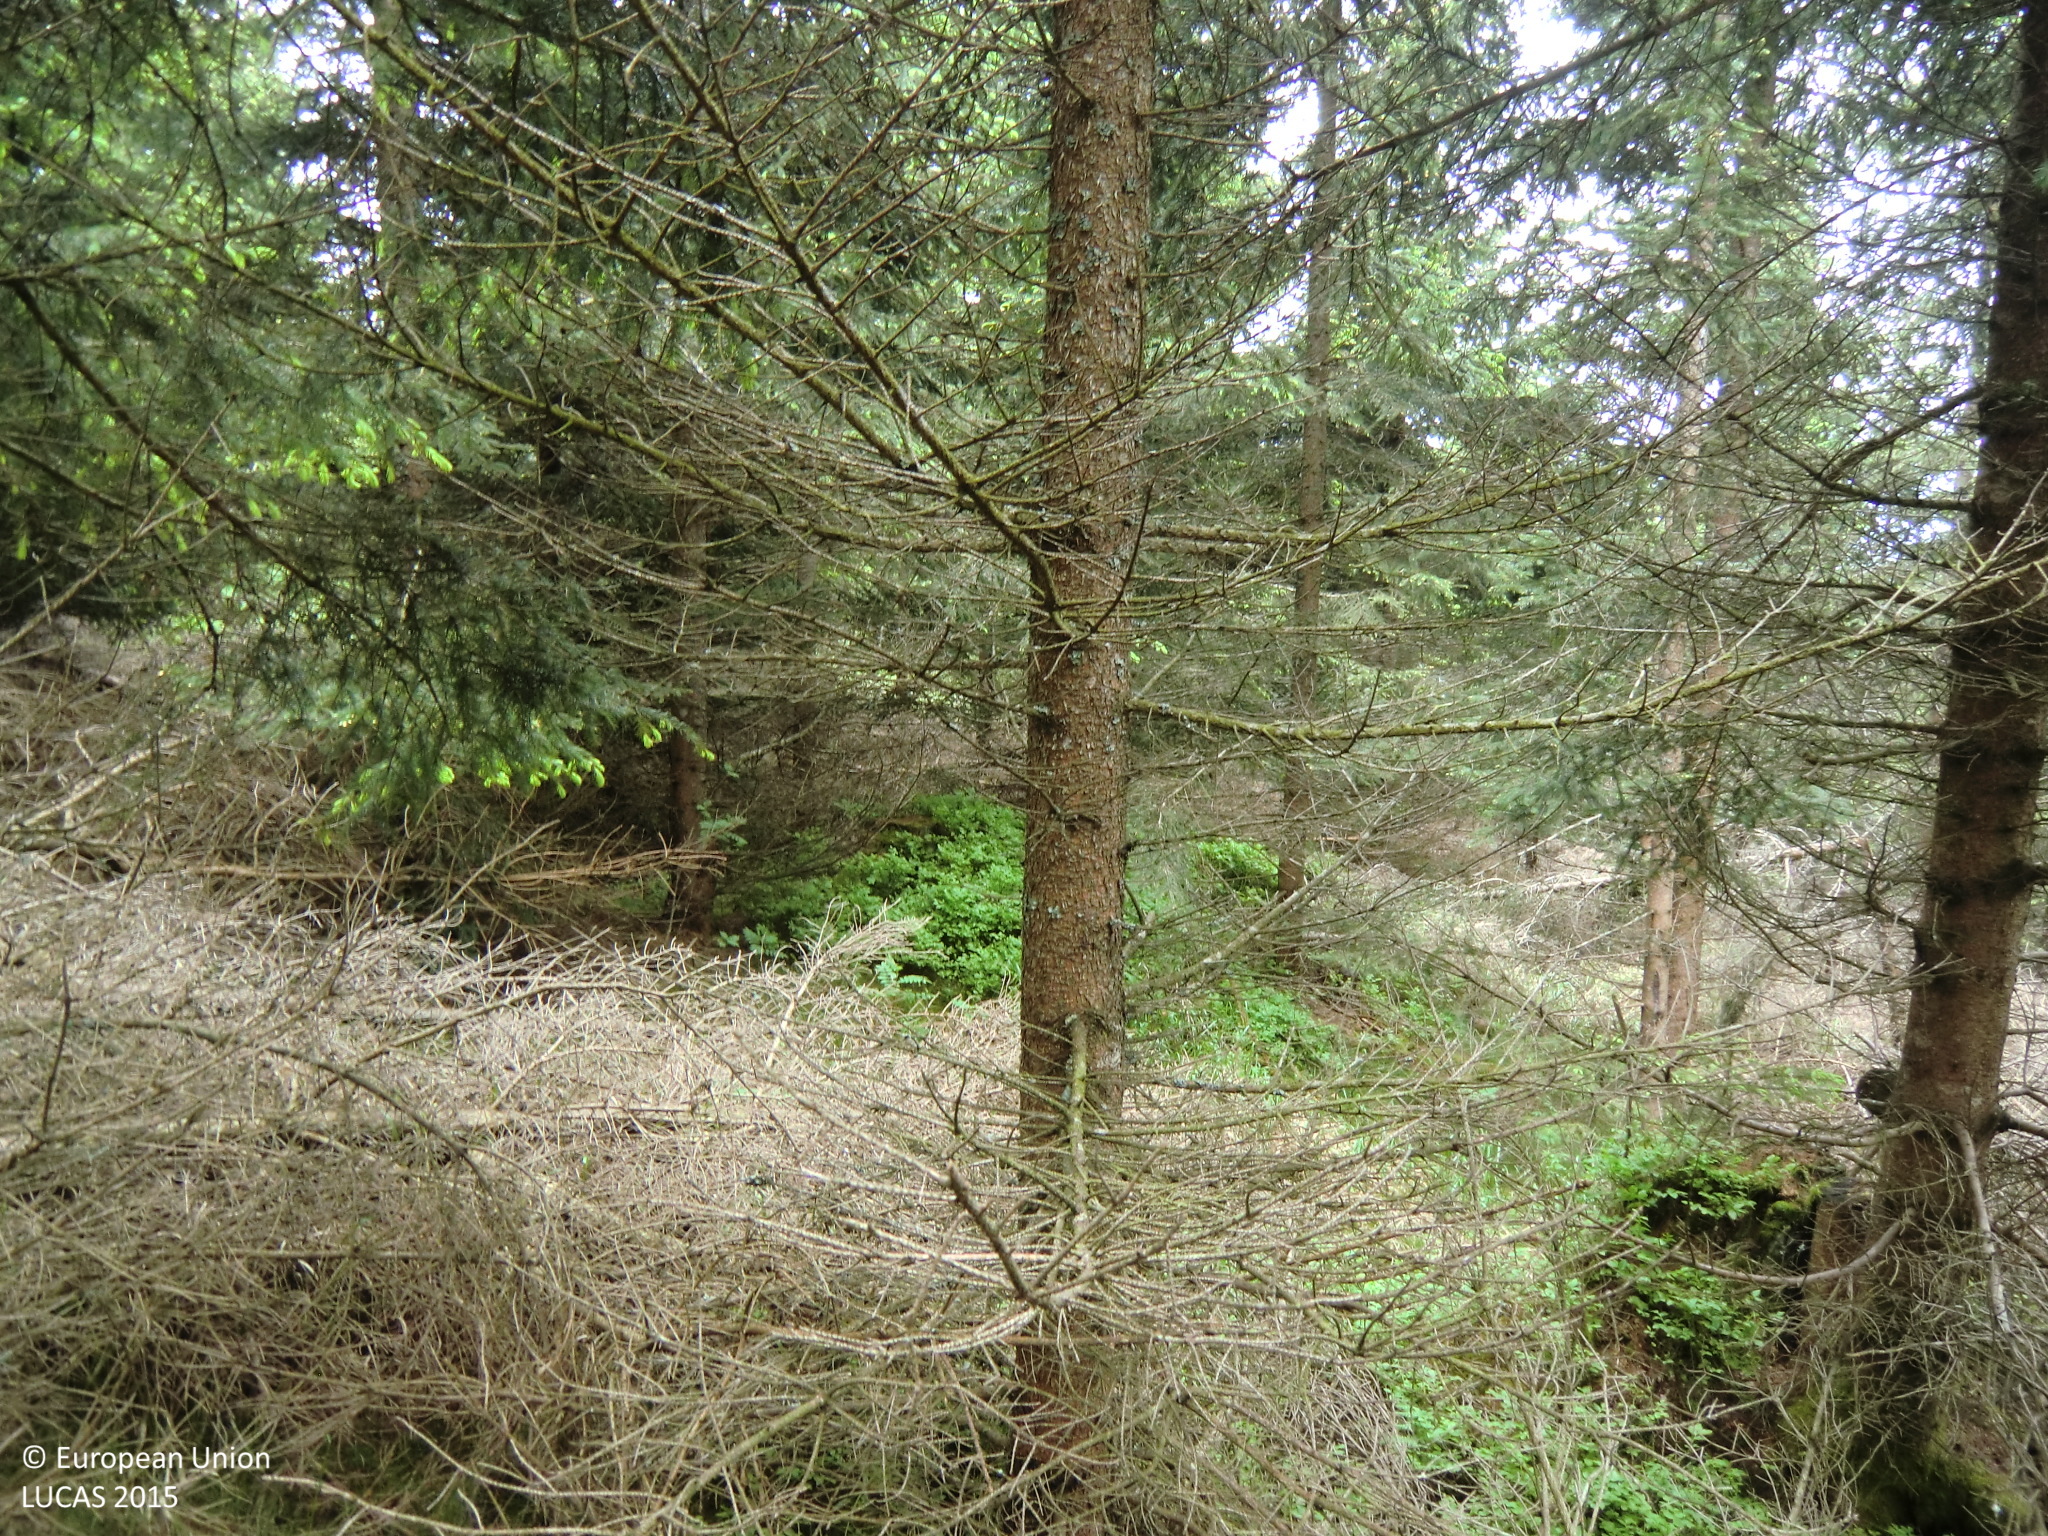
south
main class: Woodland
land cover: Spruce dominated coniferous woodland
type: hemiboreal forest and nemoral coniferous forest and mixed broadleaved-coniferous forest
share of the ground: 50 - 75 %
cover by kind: coniferous forest trees 50 %, herbaceous plants 20 %, shrubs 15 %, unconsolidated bare surface 15 %
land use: Forestry
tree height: > 5 m
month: May
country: AT
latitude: 48.3801
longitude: 15.0107
